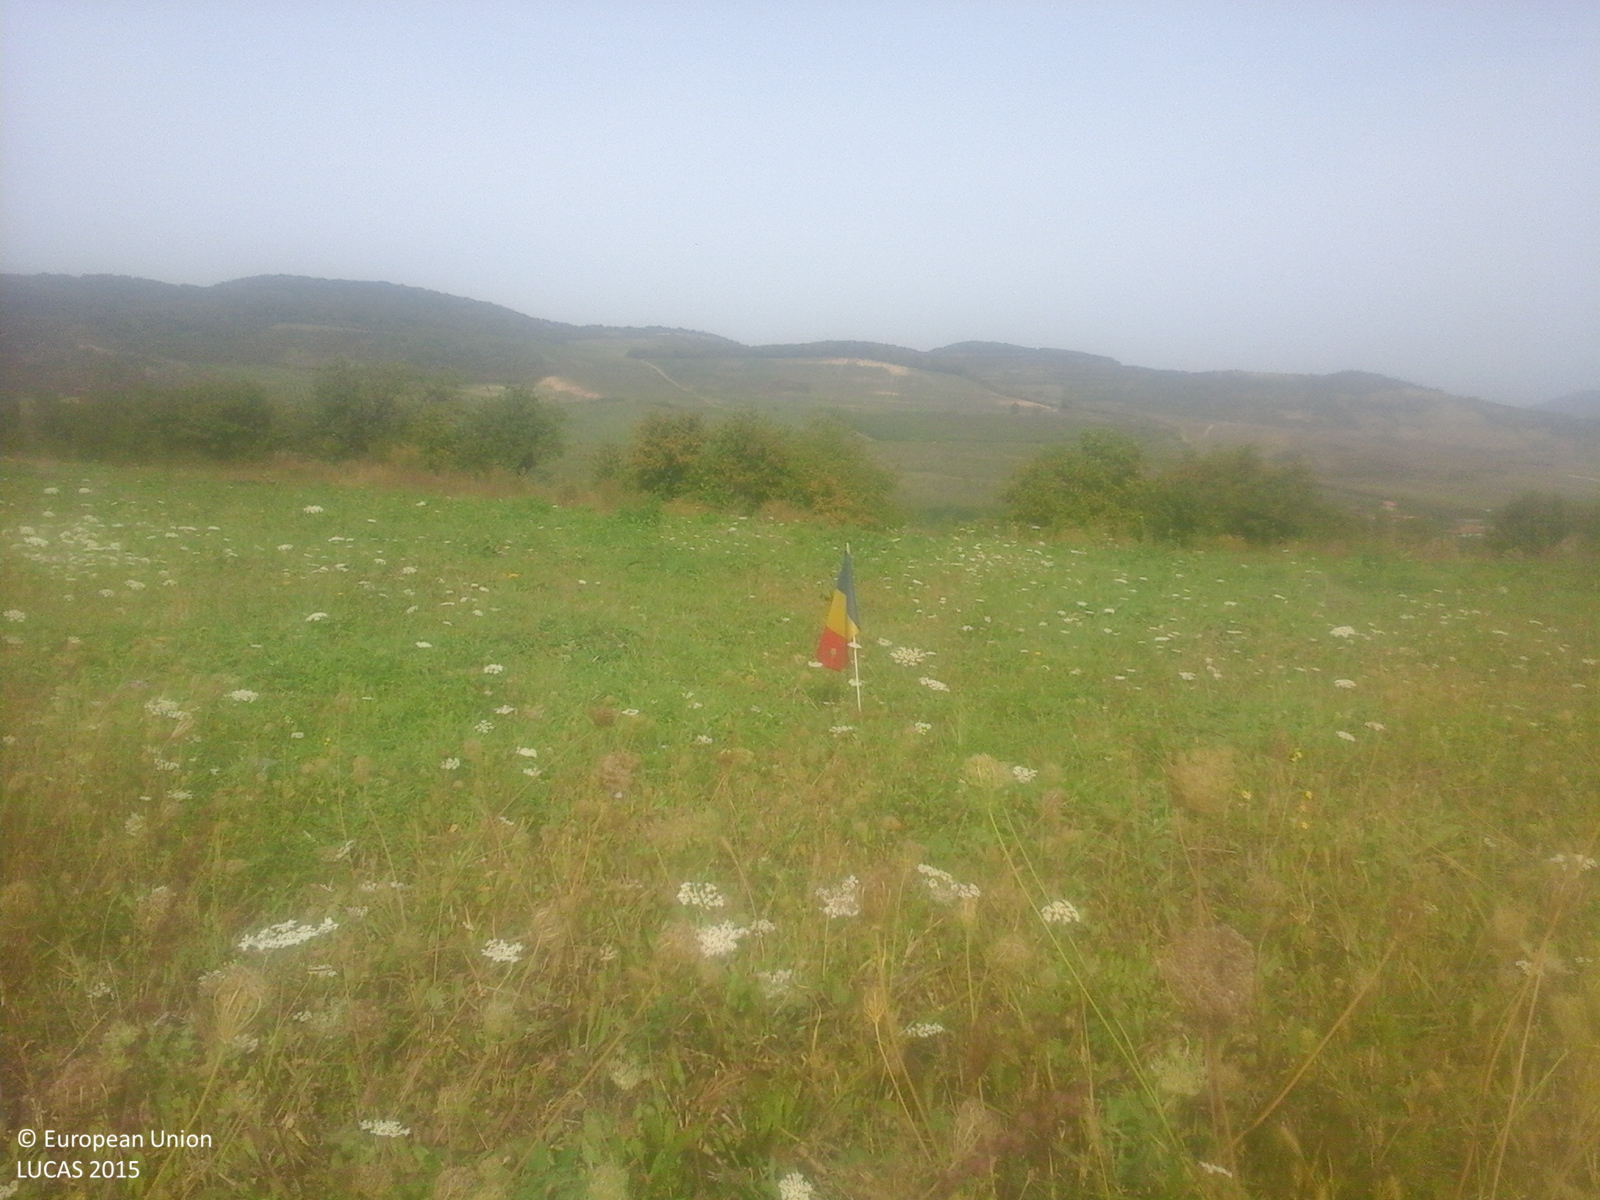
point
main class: Grassland
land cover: Spontaneously vegetated surfaces
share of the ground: > 75 %
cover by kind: herbaceous plants 100 %
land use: Agriculture (excluding fallow land and kitchen gardens)
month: September
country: RO
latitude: 47.0490
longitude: 24.2892
